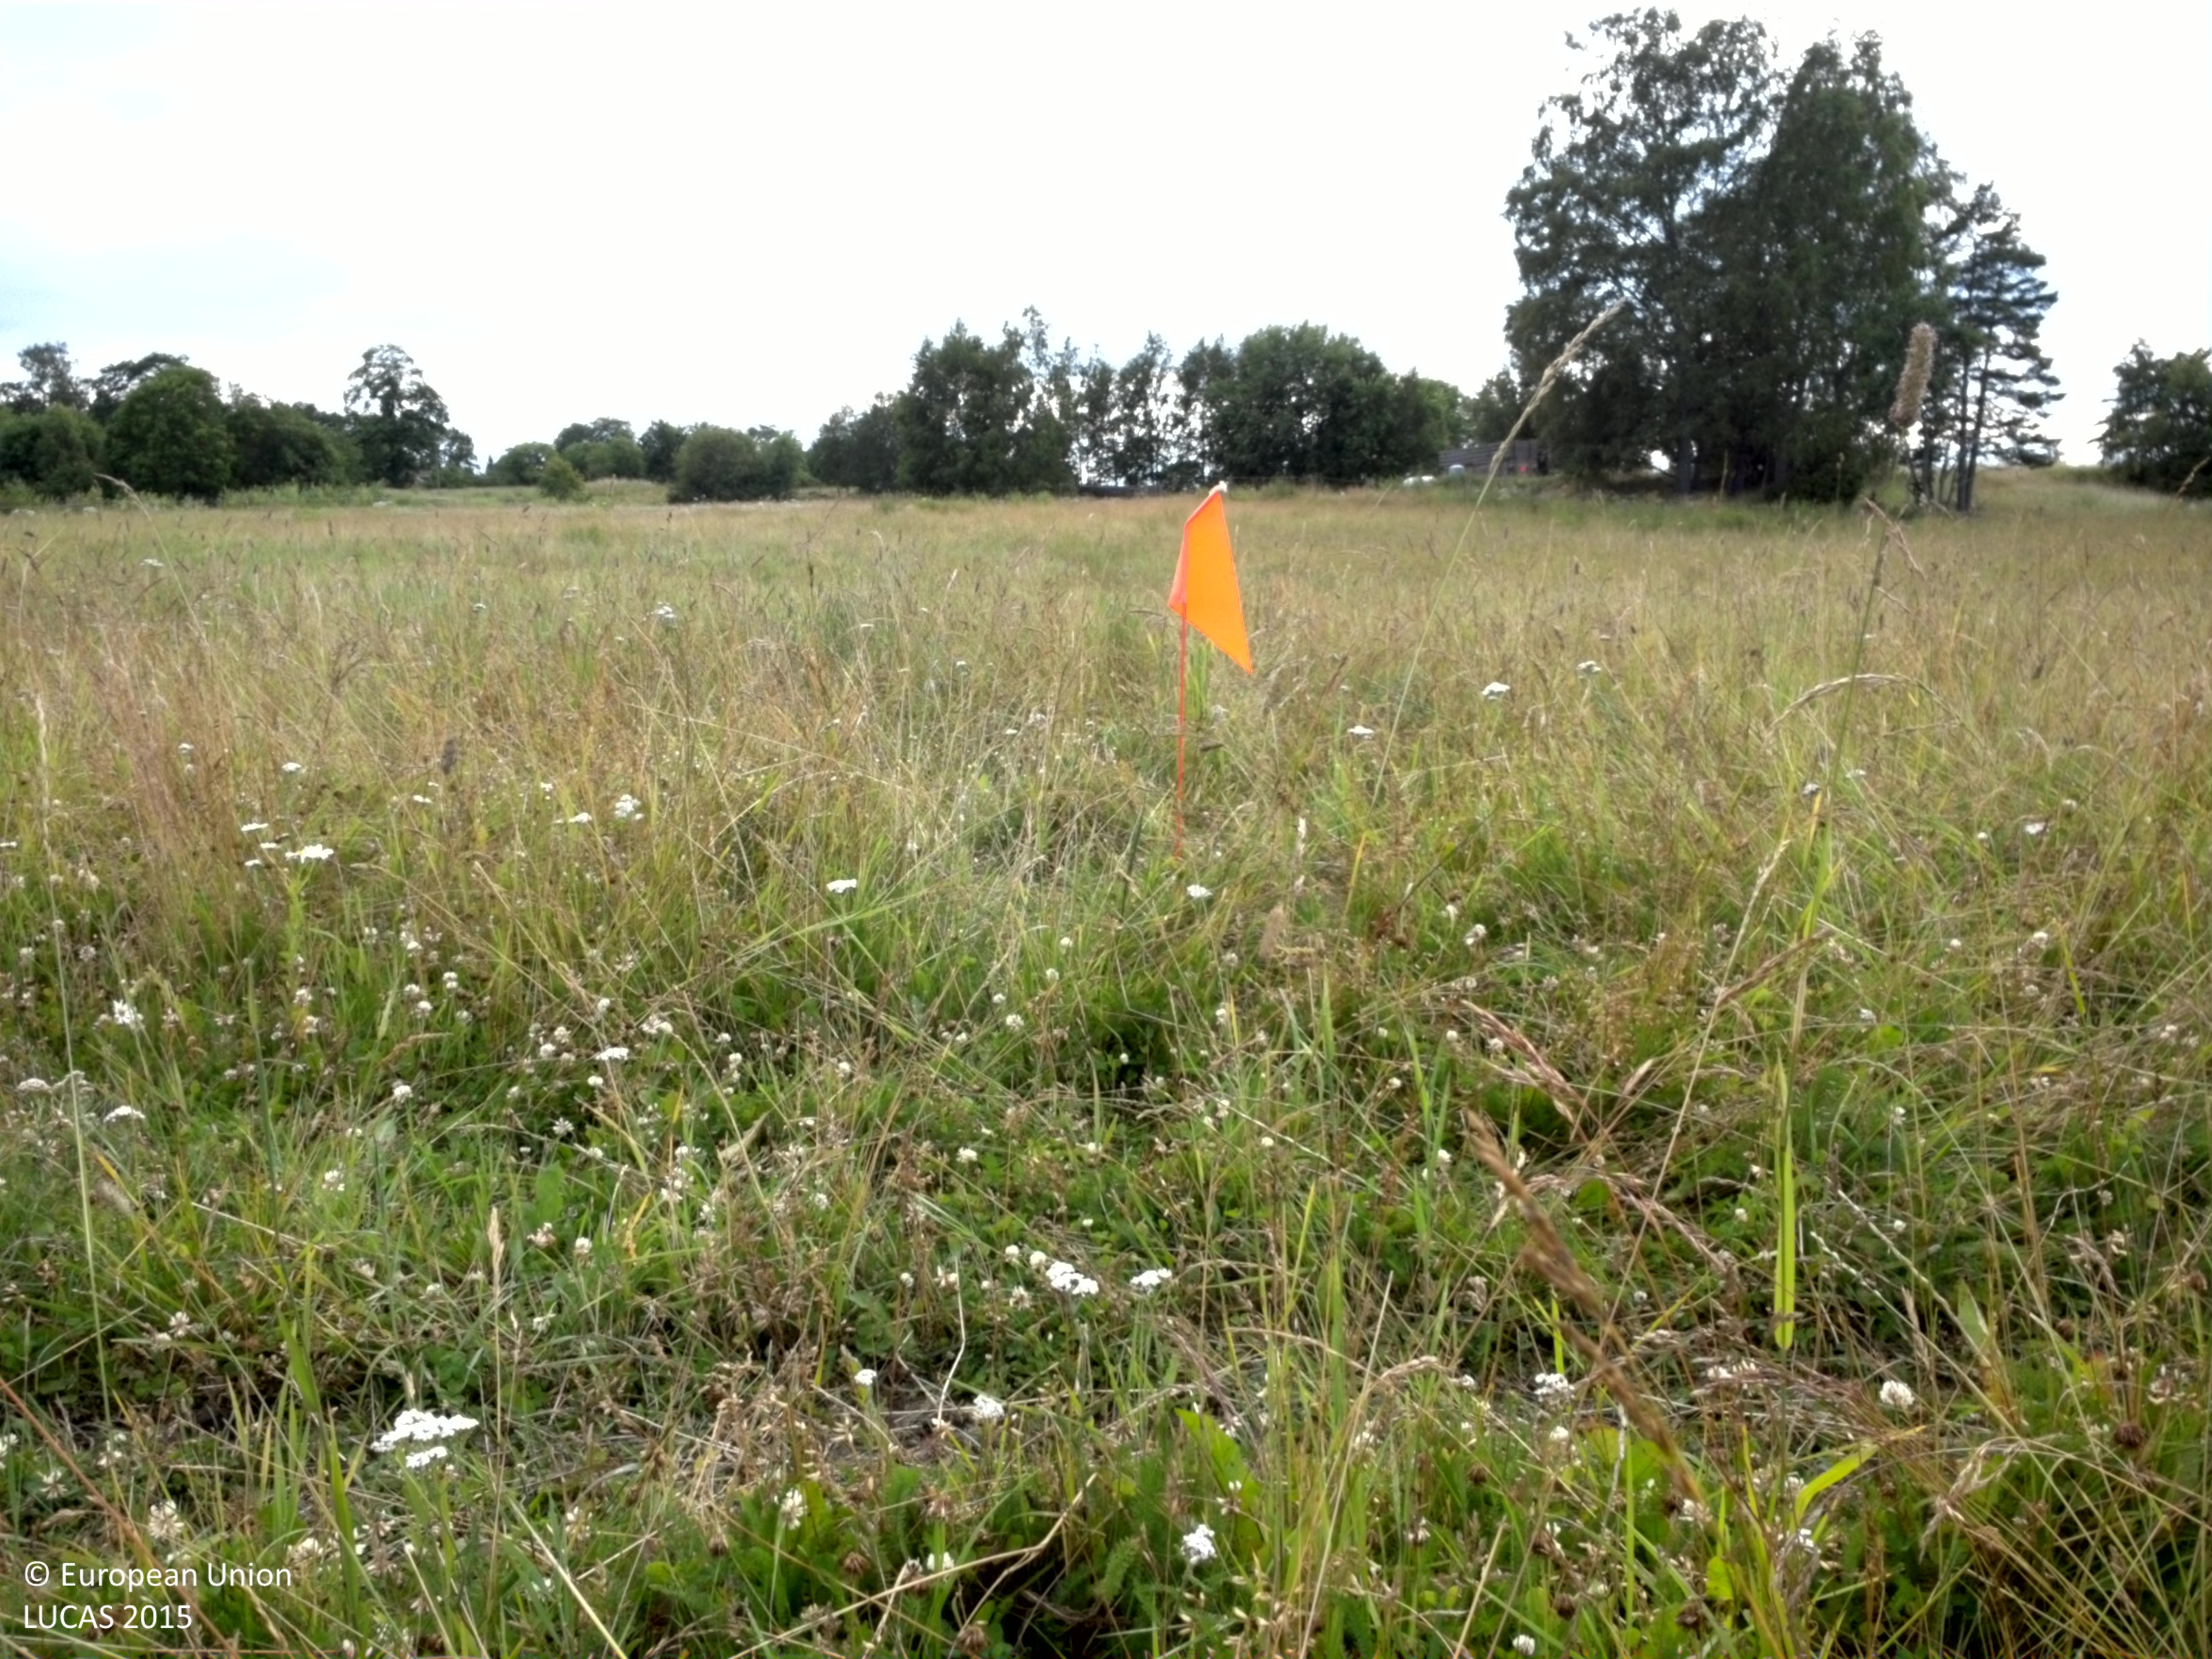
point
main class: Grassland
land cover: Grassland without tree/shrub cover
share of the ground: > 75 %
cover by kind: herbaceous plants 100 %
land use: Agriculture (excluding fallow land and kitchen gardens)
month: July
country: SE
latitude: 59.8398
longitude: 18.6895
